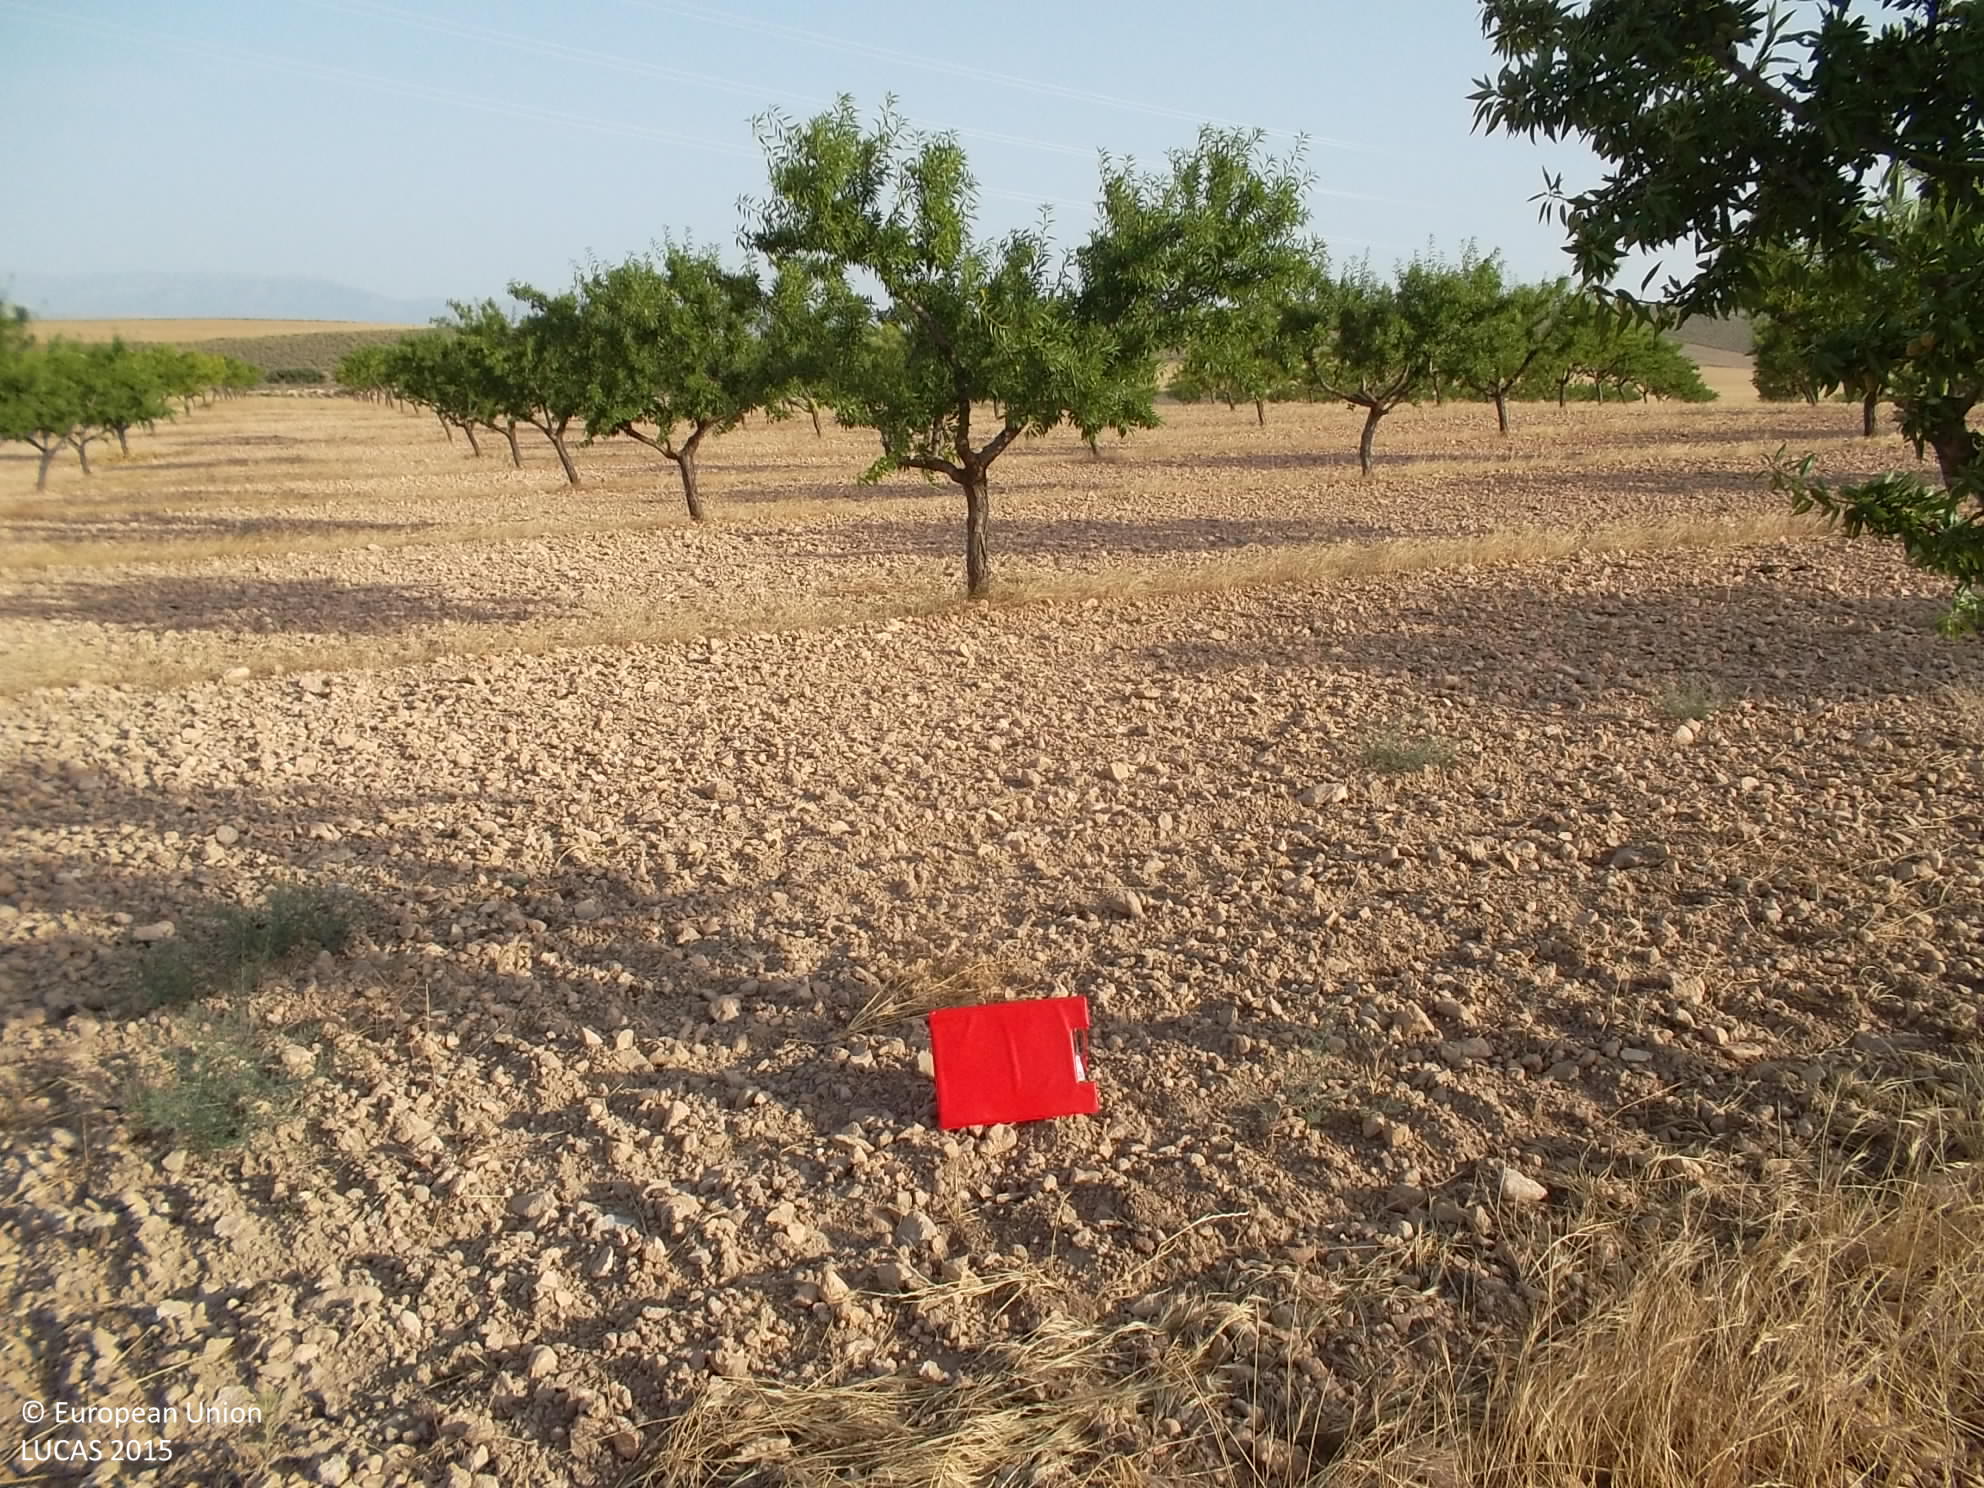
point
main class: Cropland
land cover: Nuts trees
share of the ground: 25 - 50 %
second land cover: Other bare soil
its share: > 75 %
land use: Agriculture (excluding fallow land and kitchen gardens)
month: July
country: ES
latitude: 37.8206
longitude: -2.4745
